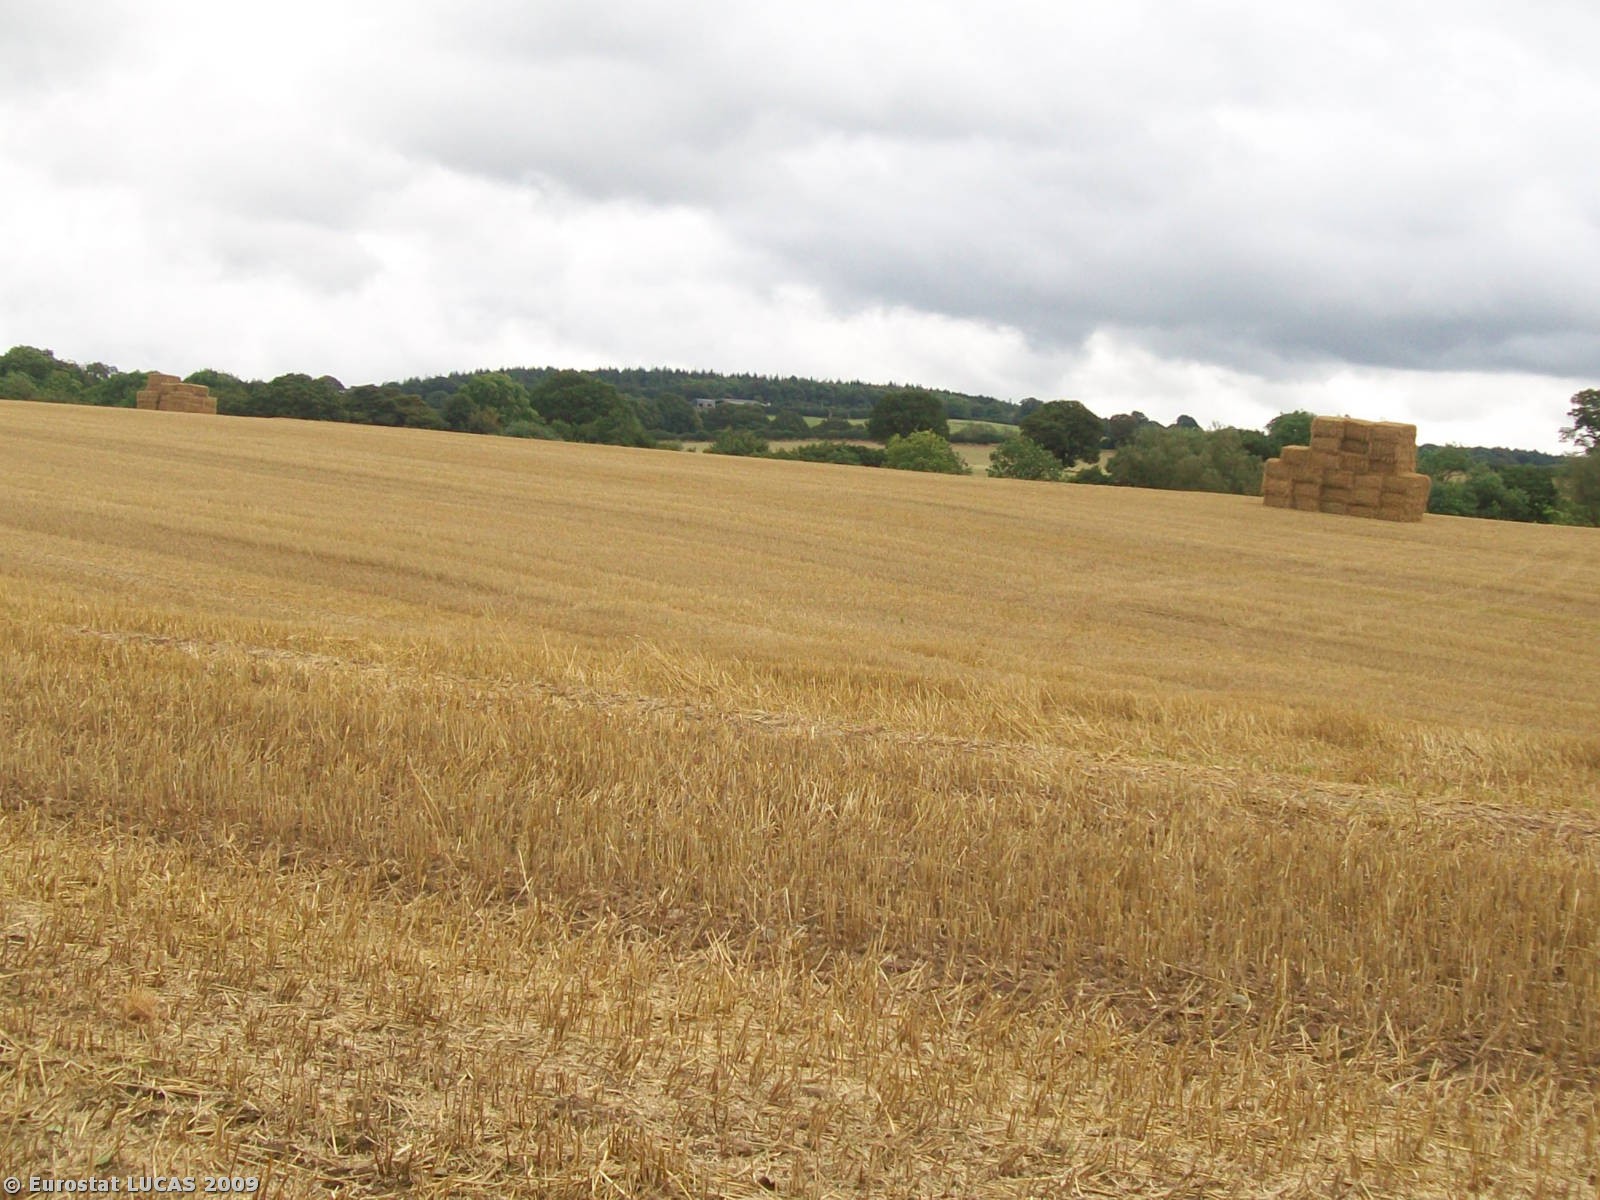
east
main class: Cropland
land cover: Common wheat
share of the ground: < 10 %
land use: Agriculture (excluding fallow land and kitchen gardens)
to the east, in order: Common wheat; Broadleaved woodland; Arable land (only in case pi)
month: September
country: GB
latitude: 52.5832
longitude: -2.5380
